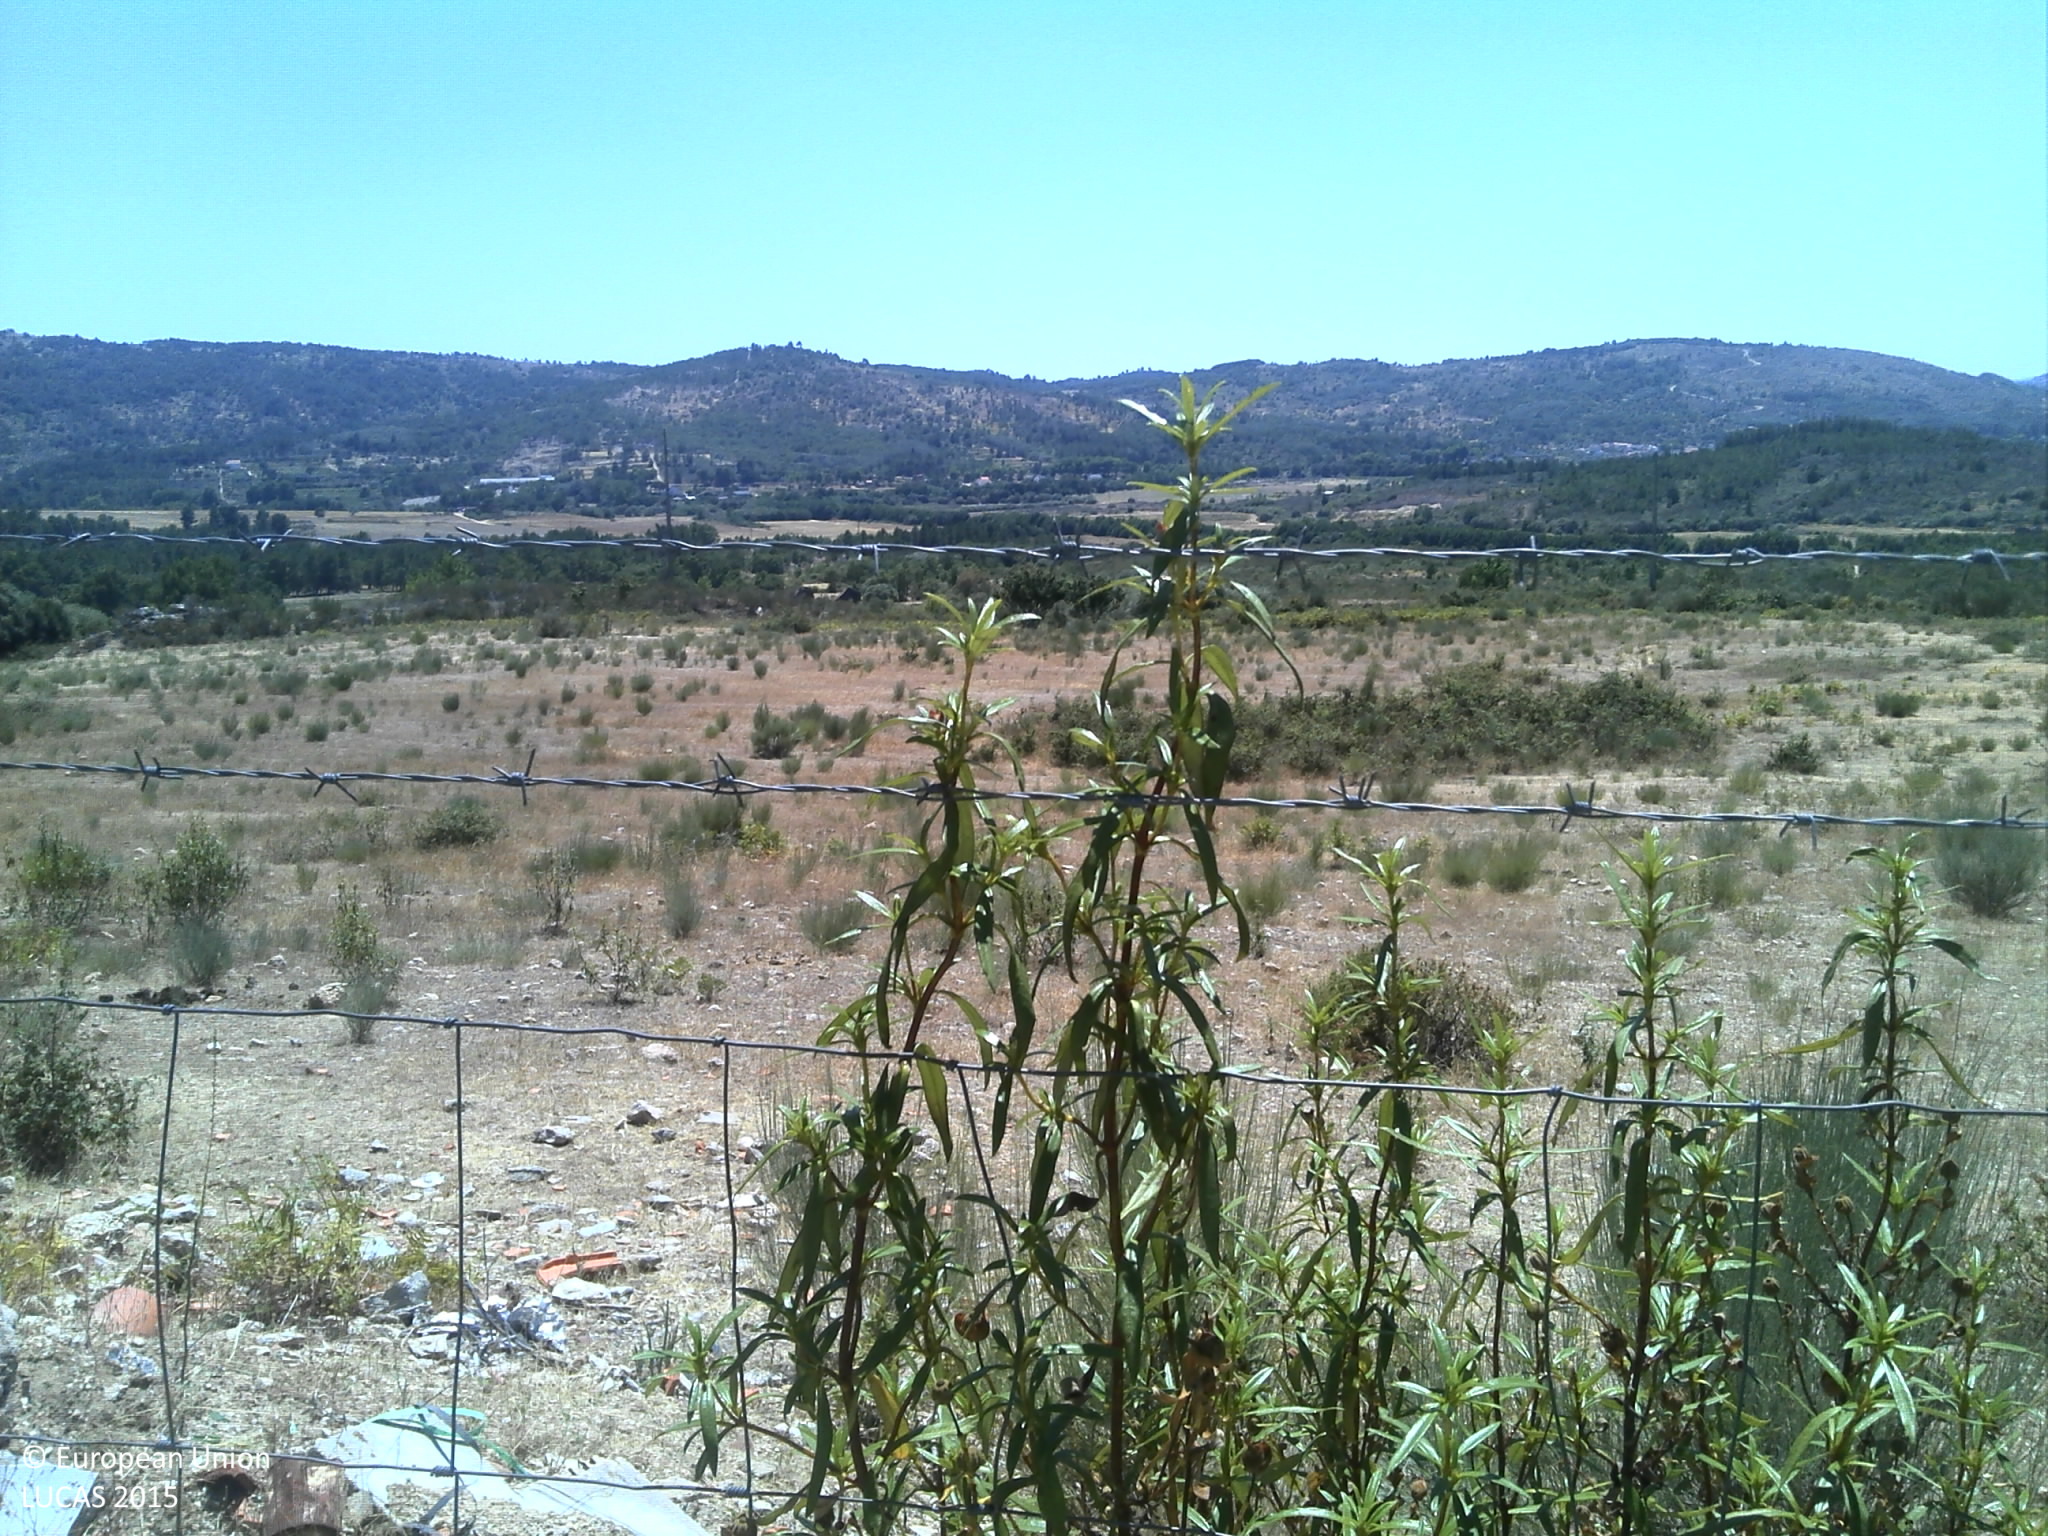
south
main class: Woodland
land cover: Broadleaved woodland
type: broadleaved evergreen forest
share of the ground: 10 - 25 %
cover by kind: herbaceous plants 40 %, unconsolidated bare surface 40 %, broadleaved forest trees 20 %
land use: Forestry
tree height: < 5 m
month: July
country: PT
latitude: 40.4282
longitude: -7.3266
